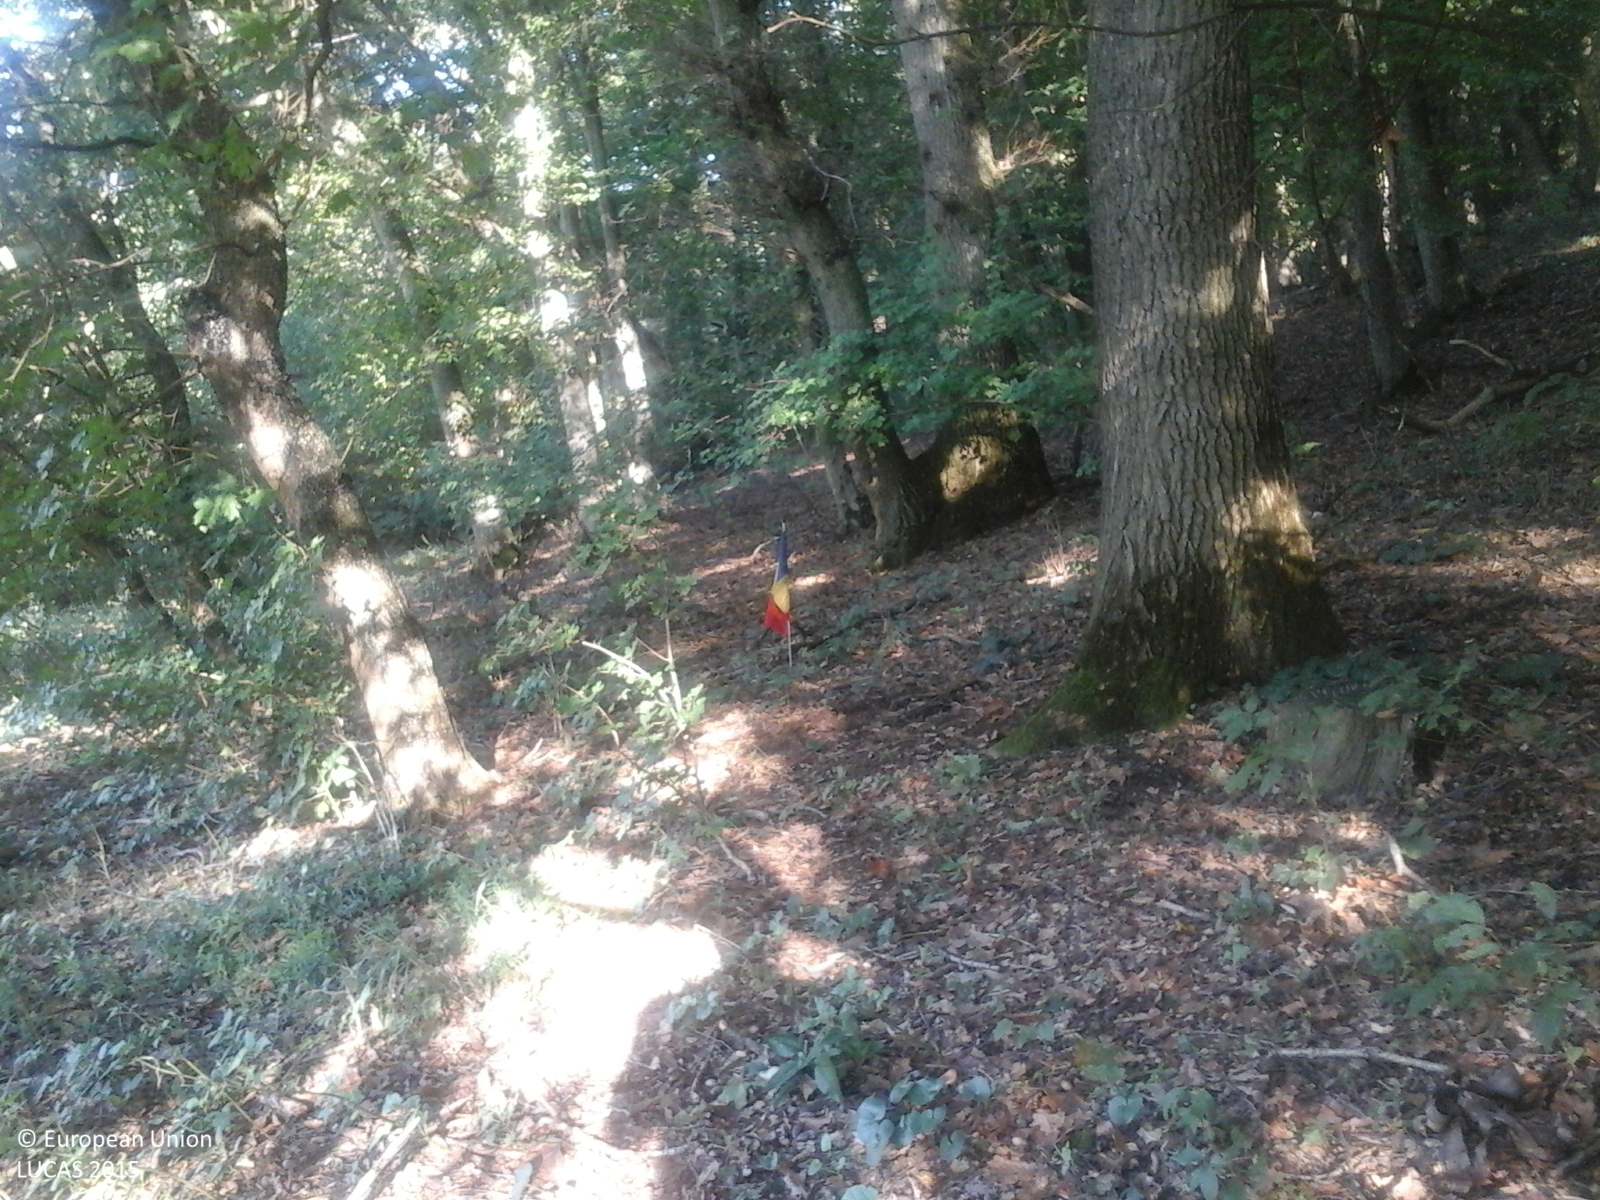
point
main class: Woodland
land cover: Broadleaved woodland
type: acidophilous oak and oak-birch forest
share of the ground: > 75 %
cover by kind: broadleaved forest trees 100 %
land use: Forestry
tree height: > 5 m
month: October
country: RO
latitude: 46.3455
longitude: 23.8064
